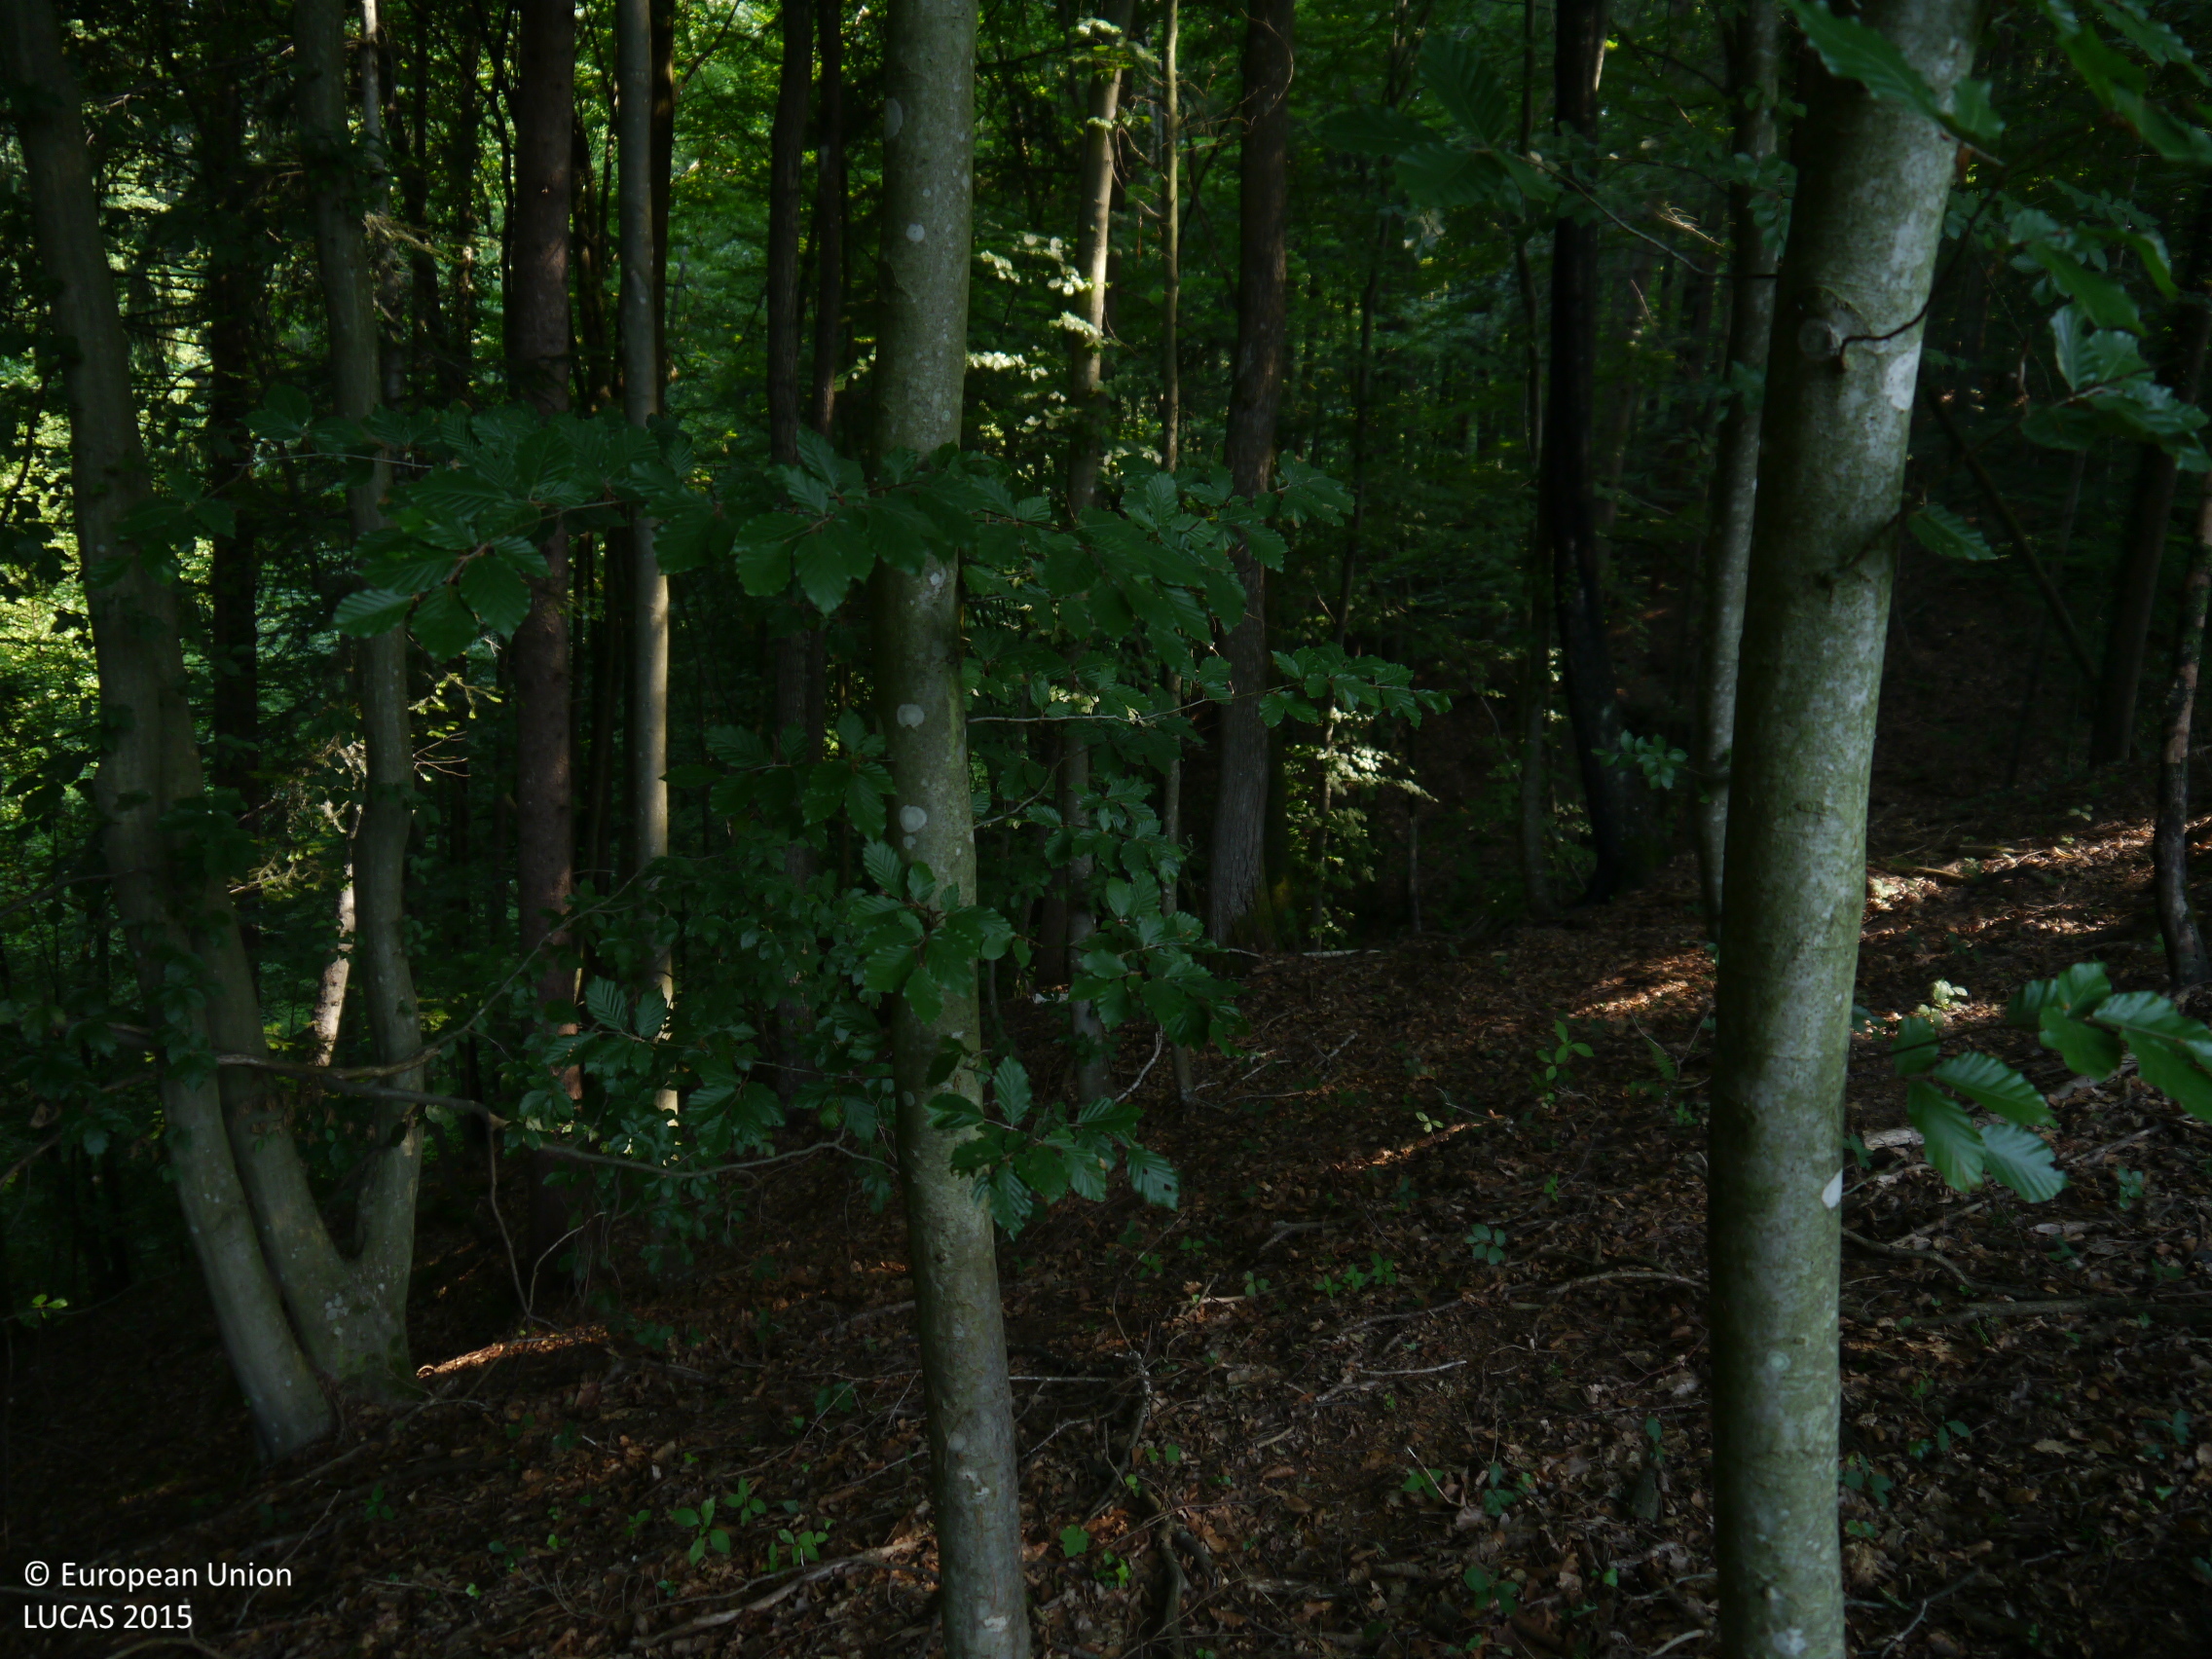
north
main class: Woodland
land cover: Broadleaved woodland
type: mountainous beech forest
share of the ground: > 75 %
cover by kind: broadleaved forest trees 90 %, coniferous forest trees 10 %
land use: Forestry
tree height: > 5 m
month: June
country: AT
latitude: 46.7817
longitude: 15.2512
